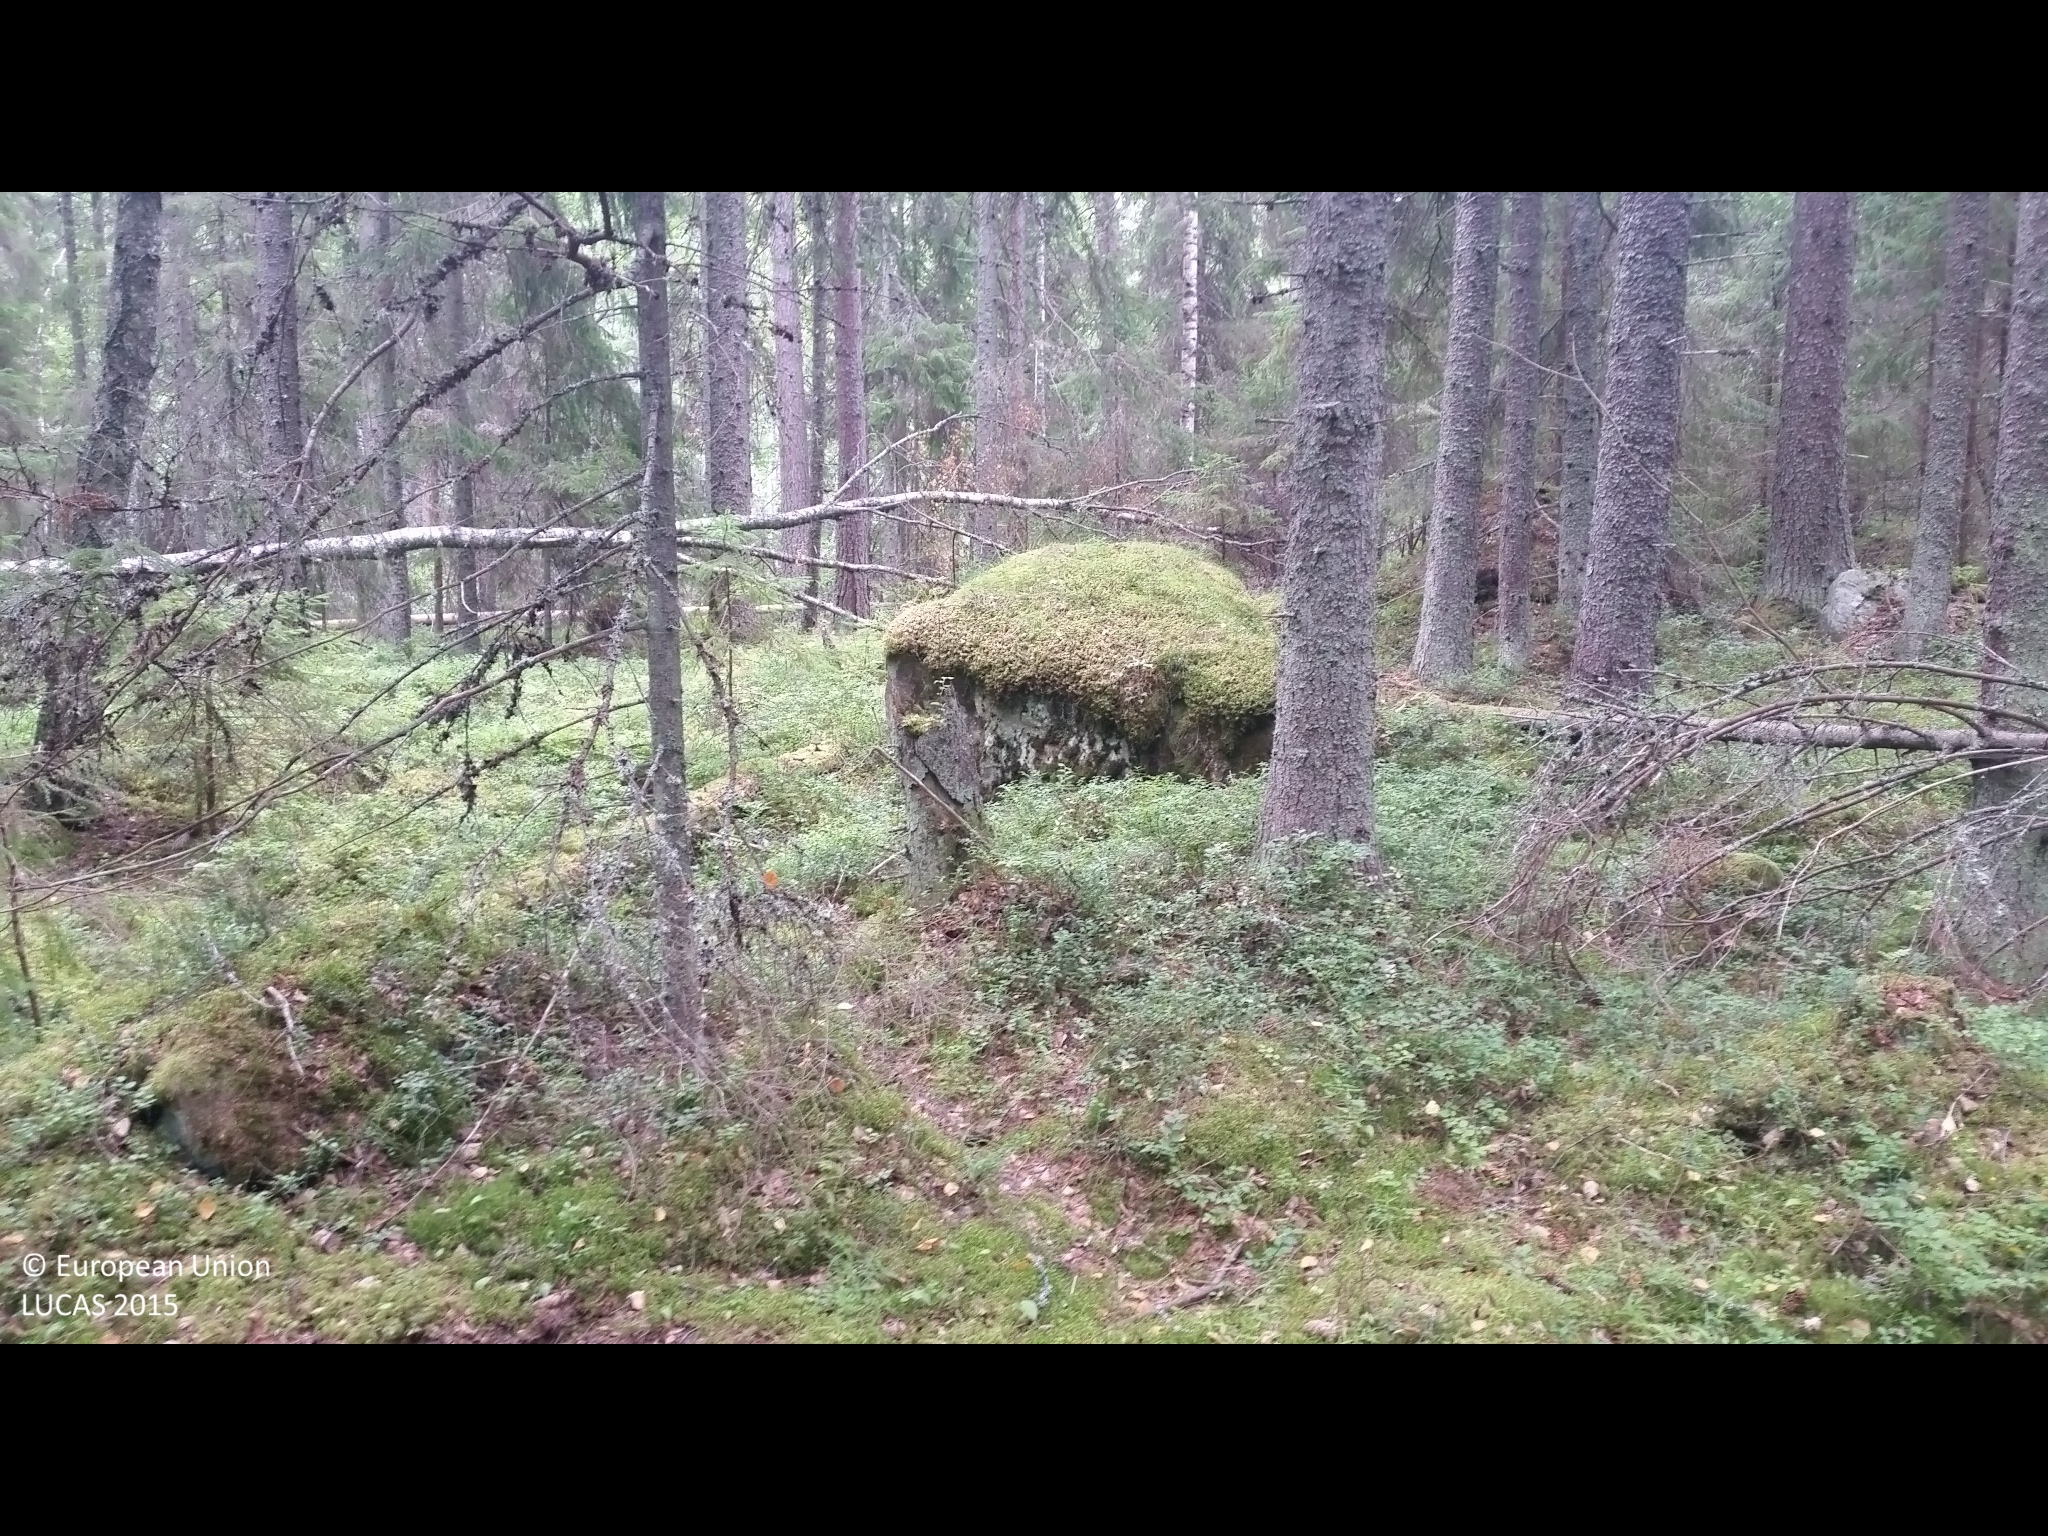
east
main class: Woodland
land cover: Spruce dominated coniferous woodland
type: boreal forest
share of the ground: > 75 %
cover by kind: coniferous forest trees 75 %, lichens and mosses 10 %, shrubs 5 %, herbaceous plants 5 %, consolidated bare surface 5 %
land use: Forestry
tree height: > 5 m
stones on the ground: < 10 %
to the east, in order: Spruce dominated coniferous woodland; Tracks; Spruce dominated coniferous woodland; Grassland with sparse tree/shrub cover; Spruce dominated coniferous woodland; Tracks; Spruce dominated coniferous woodland
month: August
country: SE
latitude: 60.8620
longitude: 17.2608
